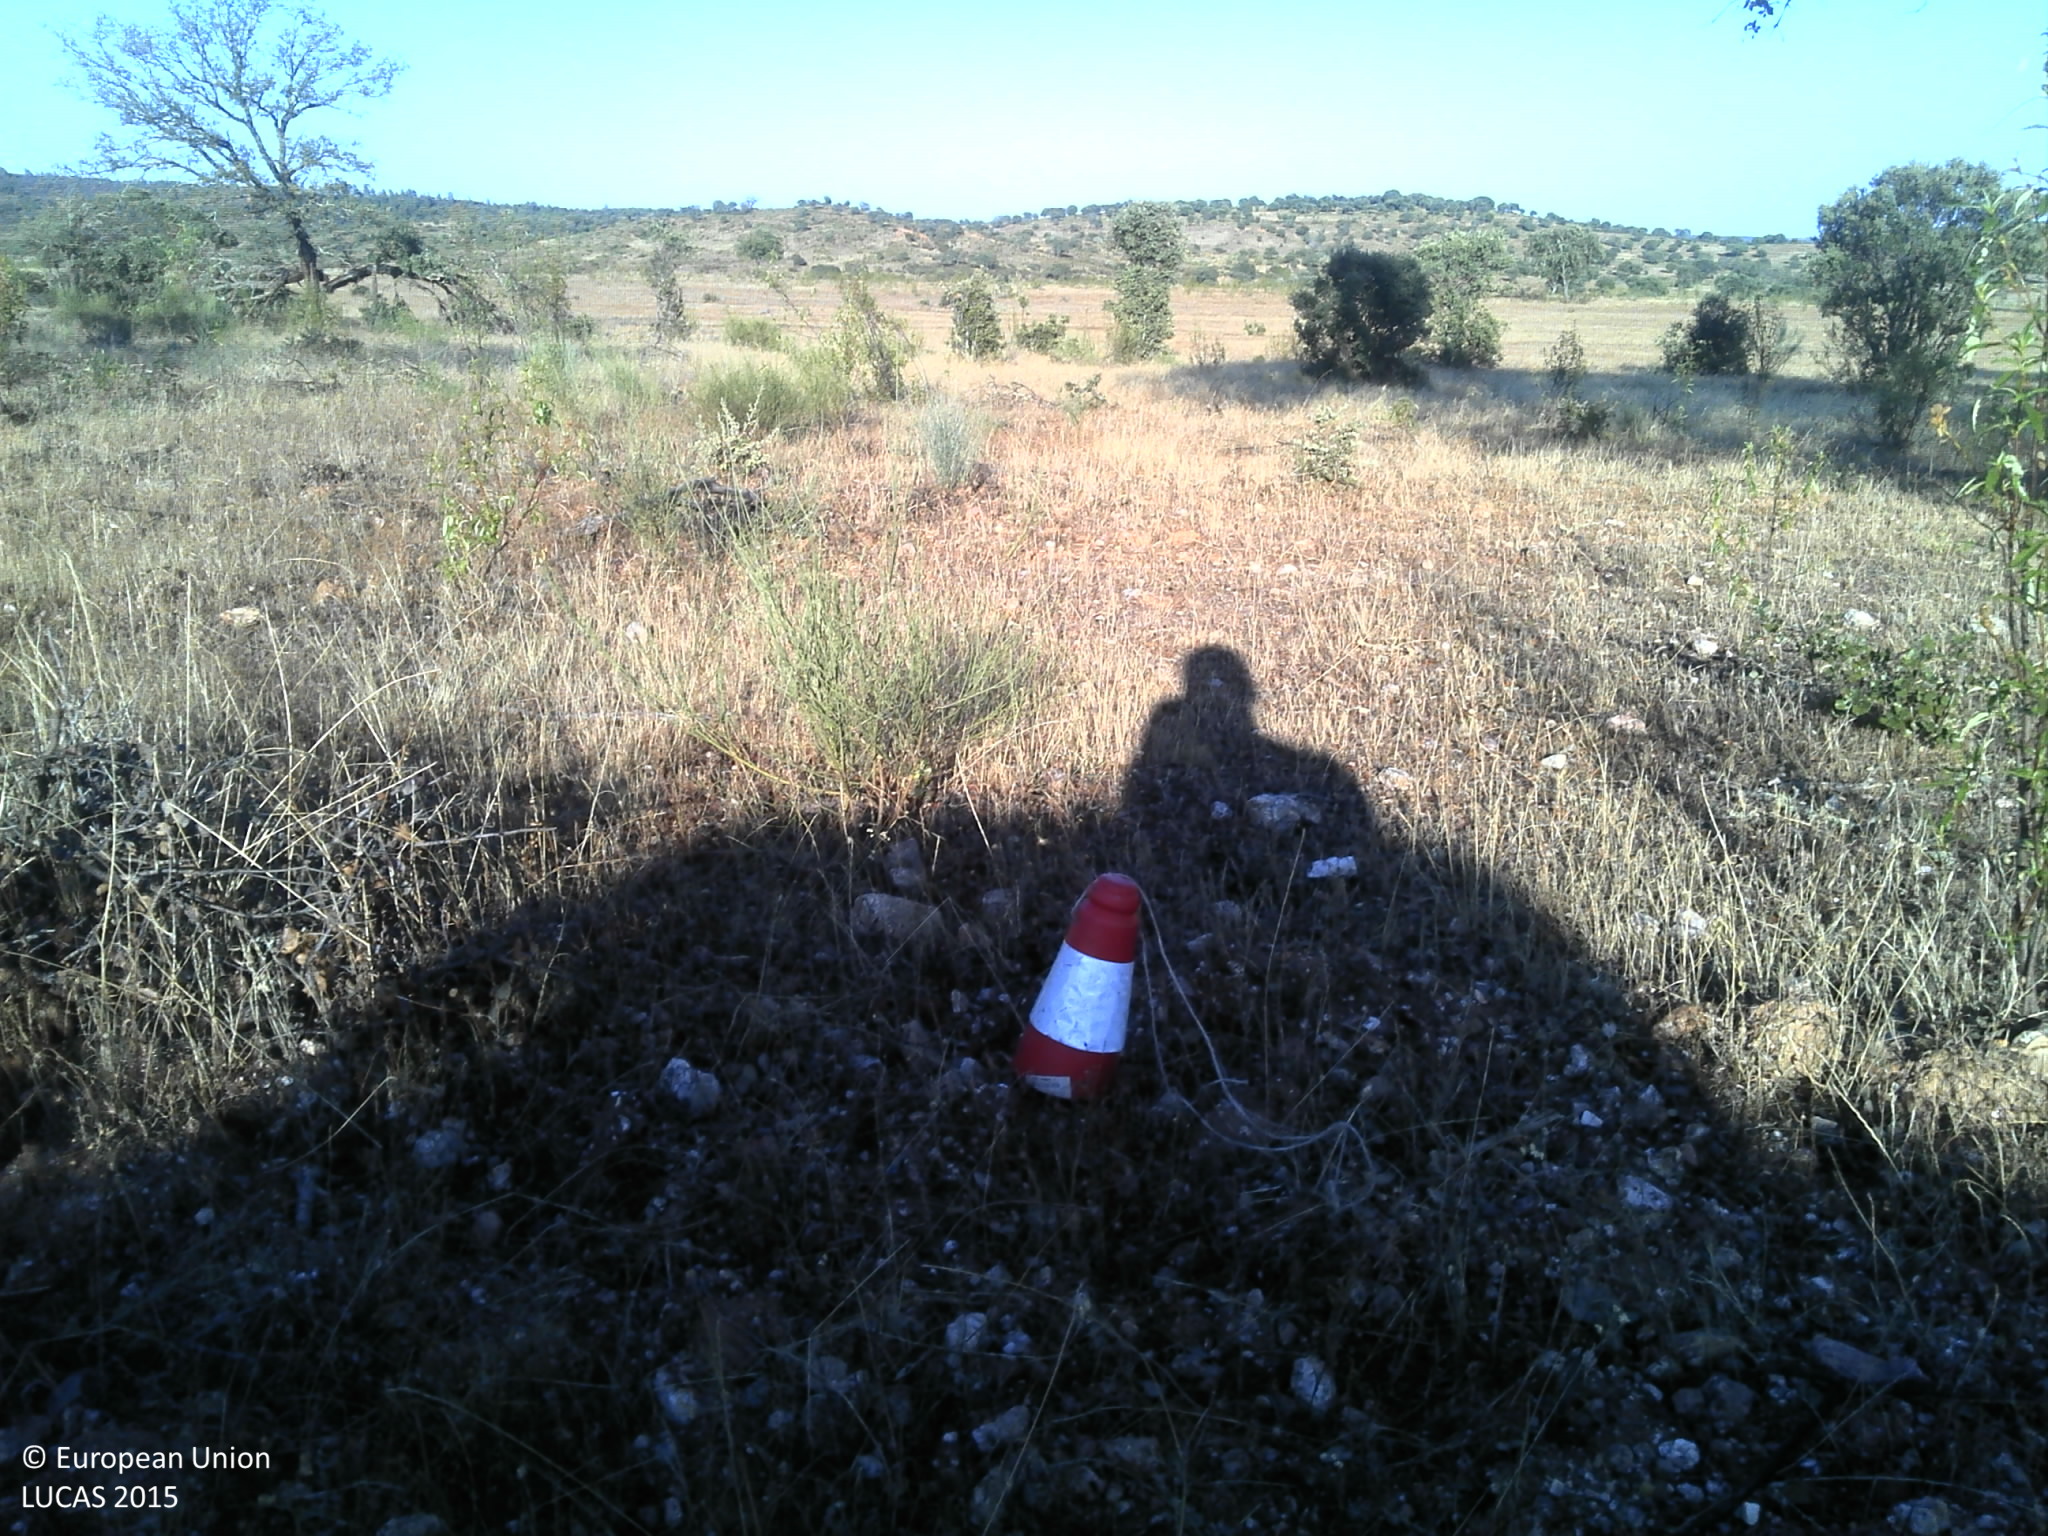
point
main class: Grassland
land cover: Grassland with sparse tree/shrub cover
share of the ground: 25 - 50 %
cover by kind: unconsolidated bare surface 45 %, herbaceous plants 40 %, broadleaved forest trees 5 %, shrubs 5 %
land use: Agriculture (excluding fallow land and kitchen gardens)
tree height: > 5 m
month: June
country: PT
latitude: 39.9388
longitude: -7.0719
